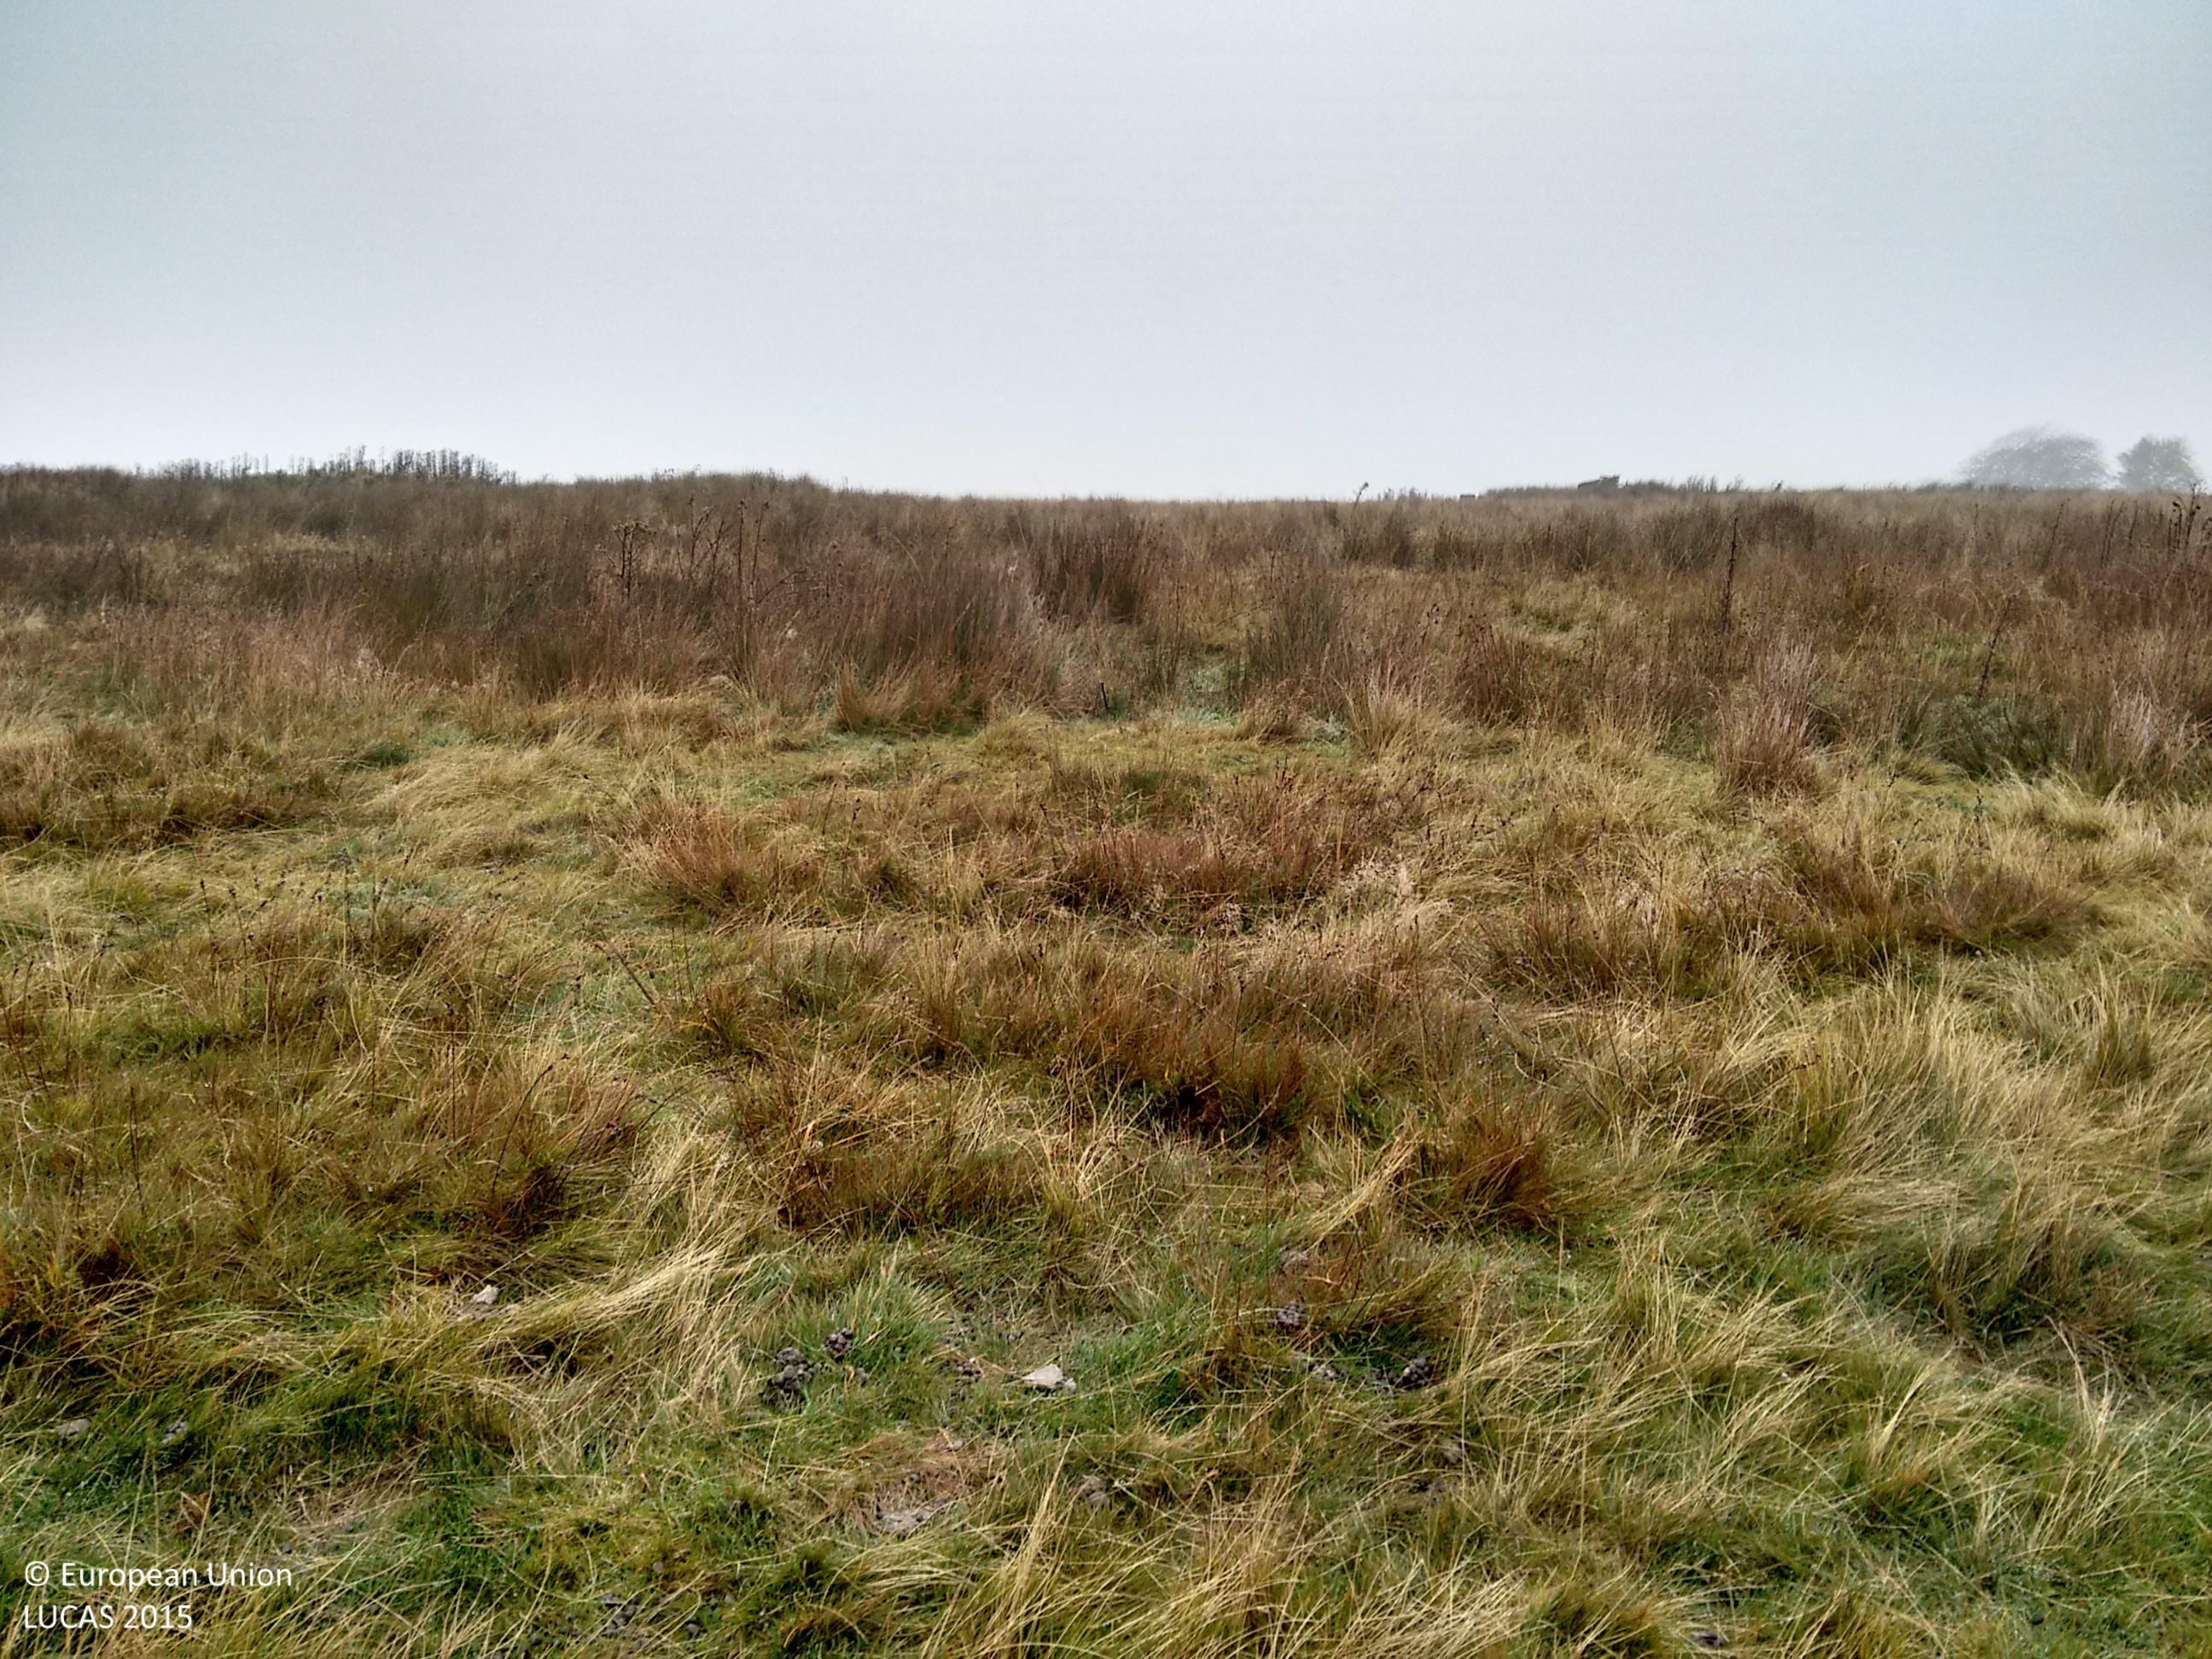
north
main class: Grassland
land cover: Grassland without tree/shrub cover
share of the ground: > 75 %
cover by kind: herbaceous plants 100 %
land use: Agriculture (excluding fallow land and kitchen gardens)
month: October
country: GB
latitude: 54.5274
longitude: -2.0313
